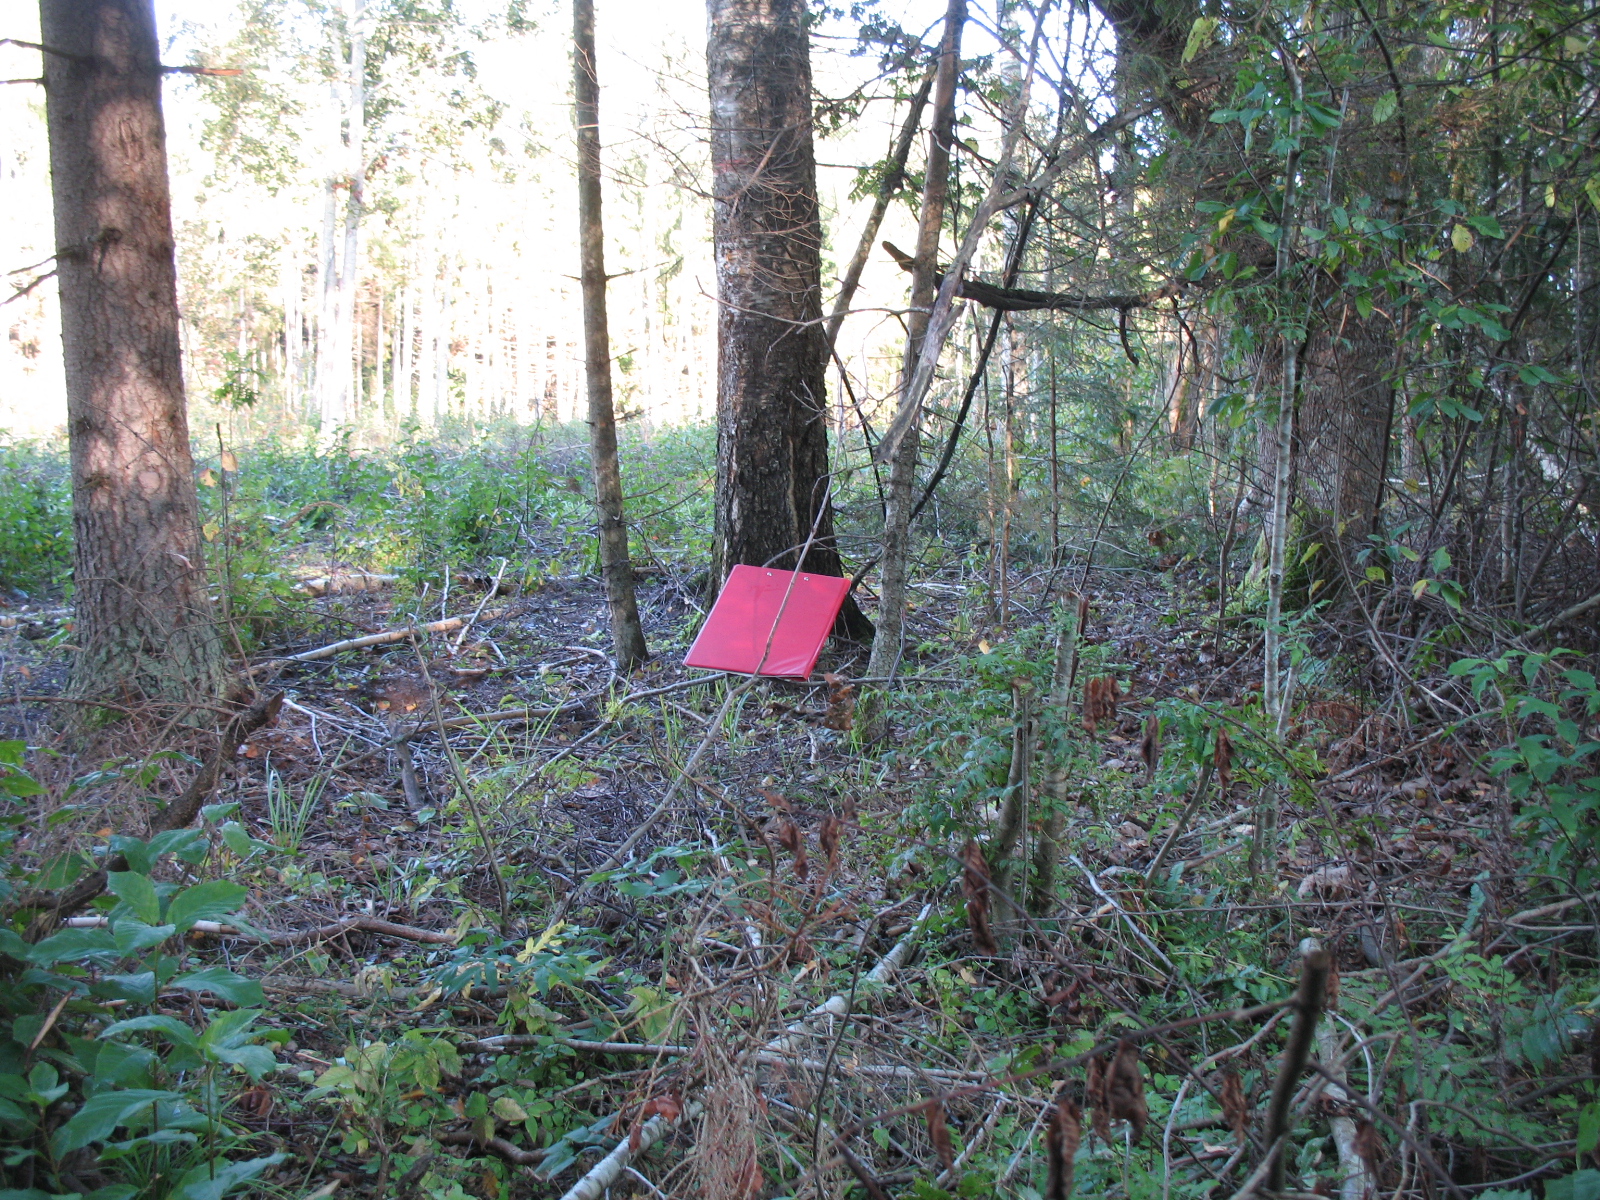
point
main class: Woodland
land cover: Spruce dominated mixed woodland
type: hemiboreal forest and nemoral coniferous forest and mixed broadleaved-coniferous forest
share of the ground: > 75 %
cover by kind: broadleaved forest trees 55 %, coniferous forest trees 25 %, shrubs 10 %, herbaceous plants 10 %
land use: Forestry
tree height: > 5 m
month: September
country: LV
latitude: 56.1396
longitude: 25.9201
